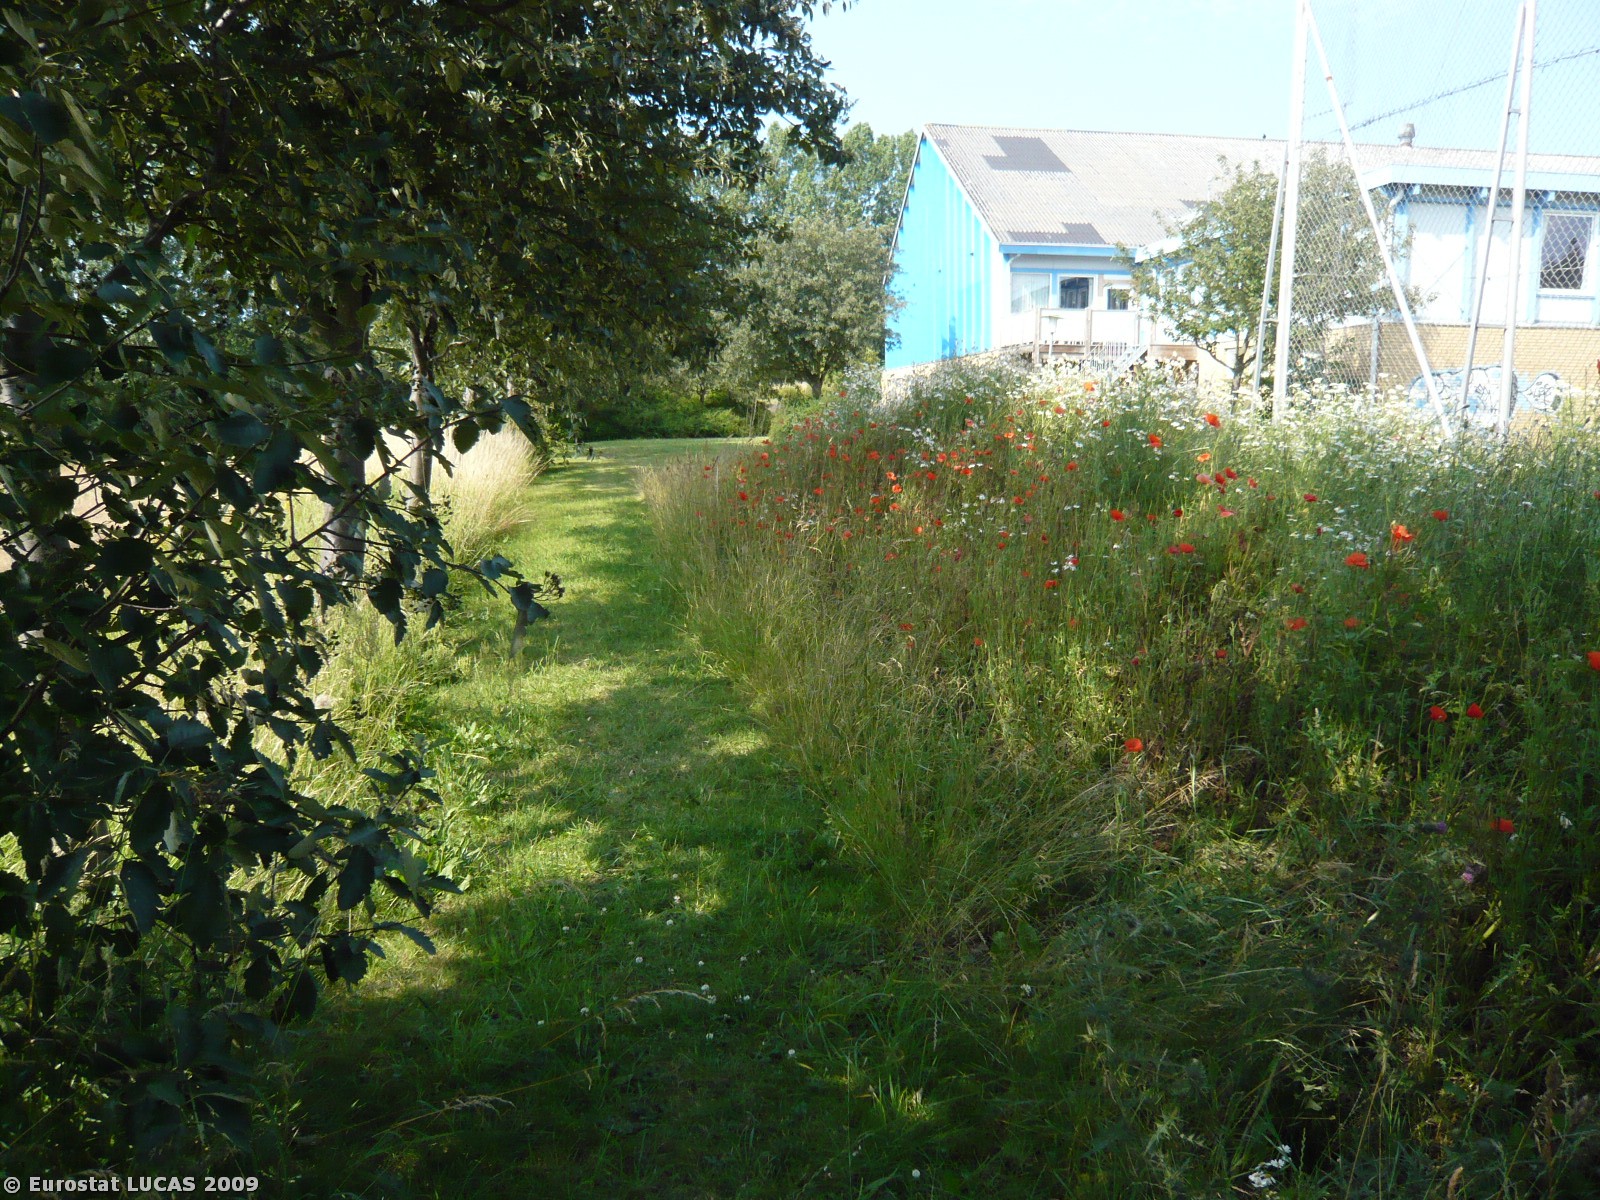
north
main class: Woodland
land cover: Broadleaved woodland
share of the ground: > 75 %
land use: Sport
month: July
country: DK
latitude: 55.9079
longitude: 11.6140
